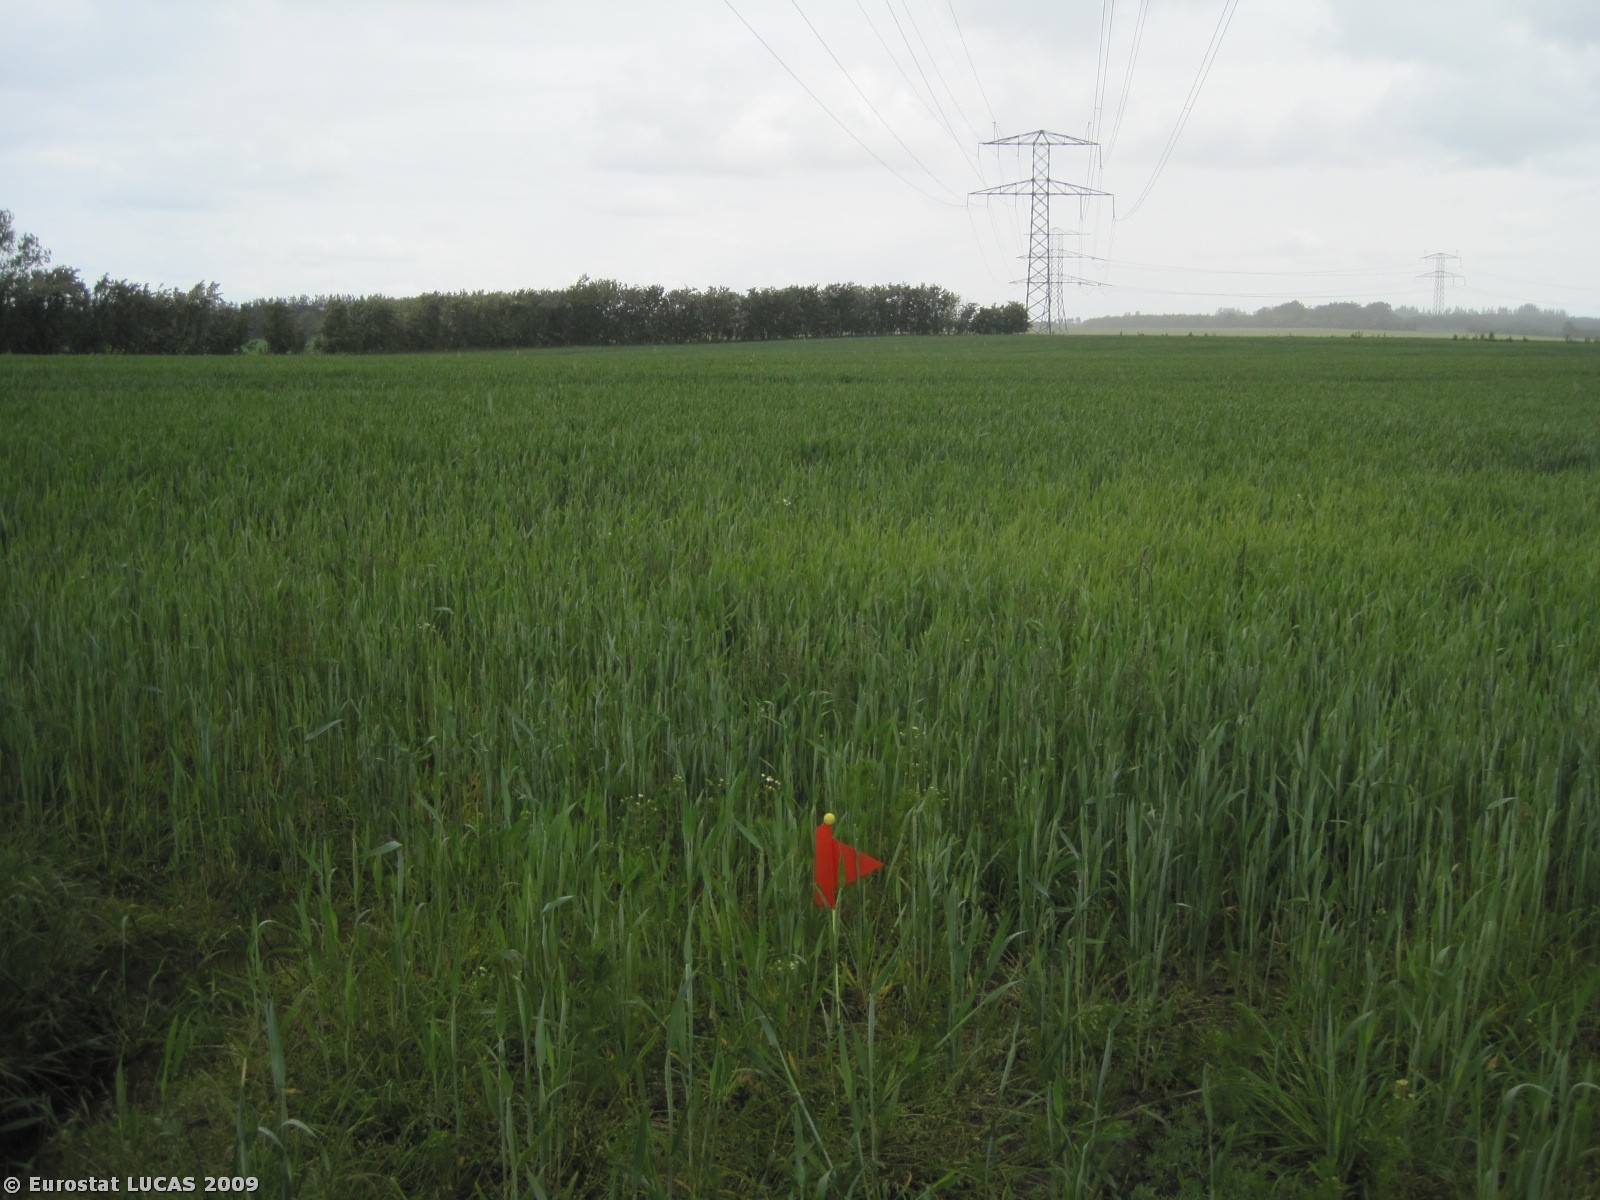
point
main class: Cropland
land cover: Common wheat
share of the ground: > 75 %
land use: Agriculture (excluding fallow land and kitchen gardens)
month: June
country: DK
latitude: 56.9426
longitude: 9.7866
